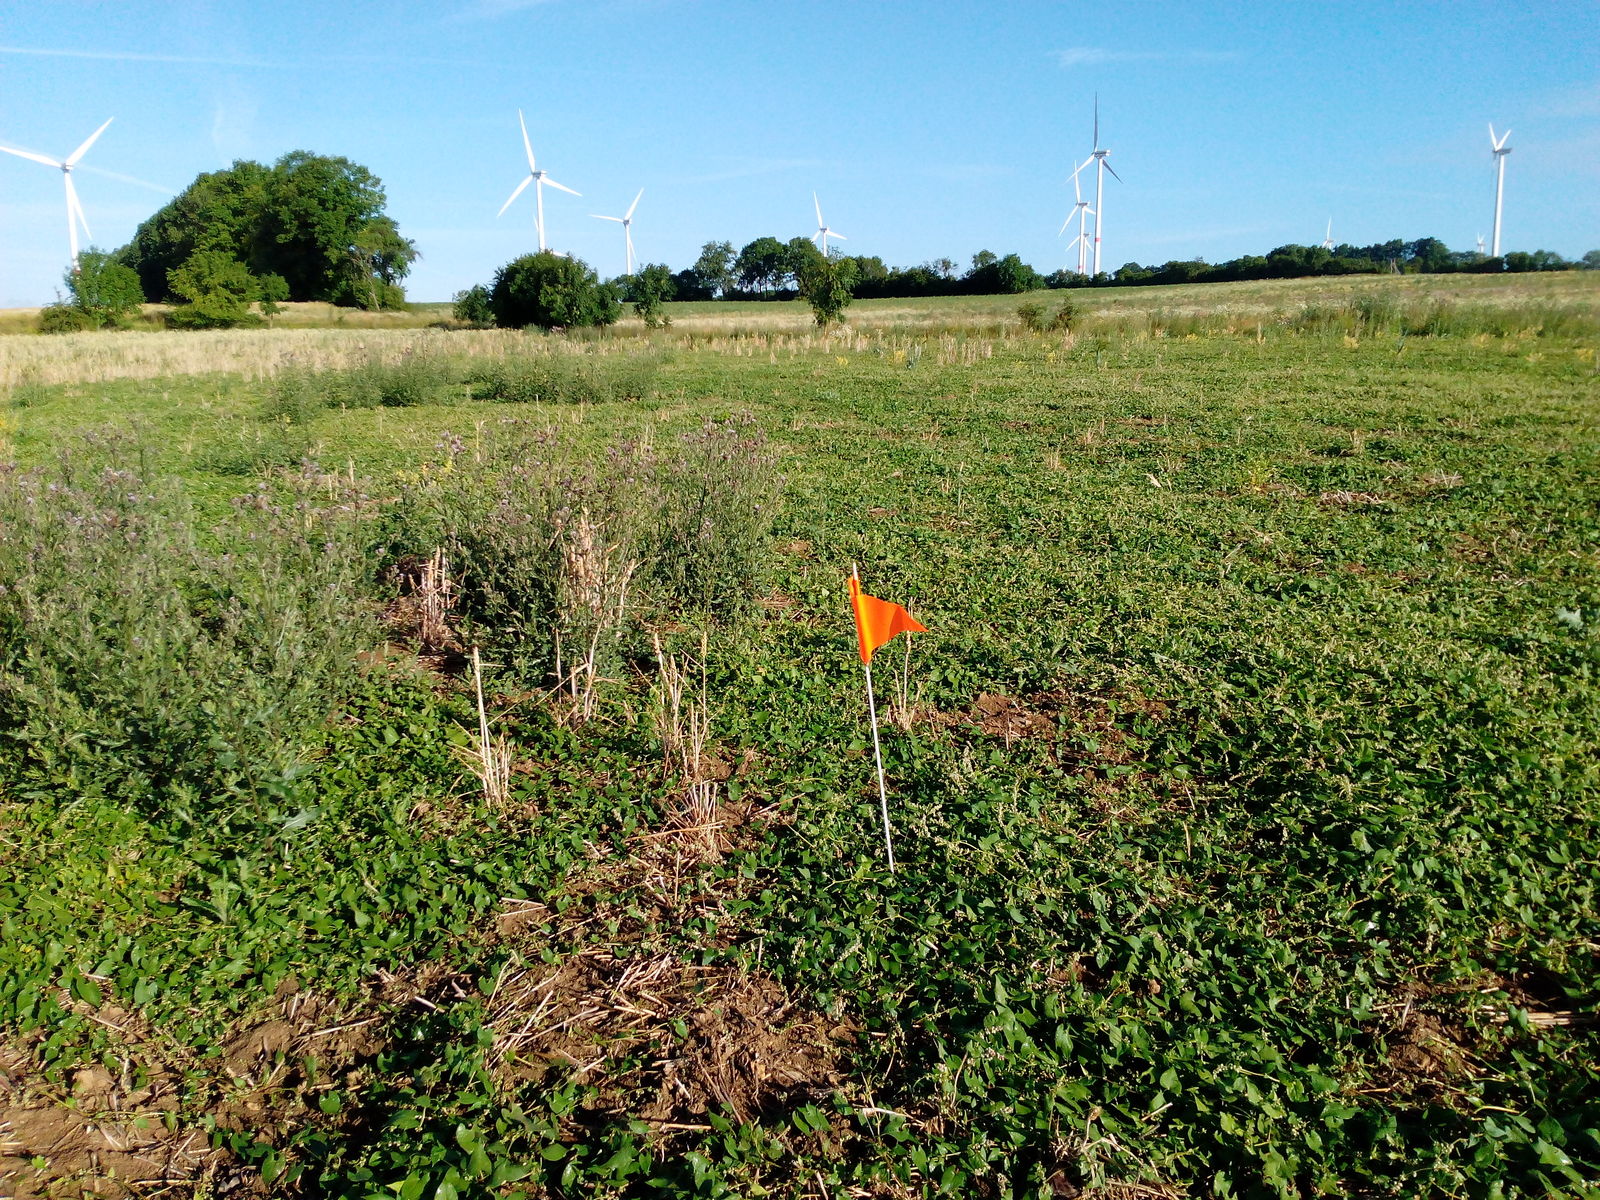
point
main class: Grassland
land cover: Spontaneously vegetated surfaces
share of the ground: > 75 %
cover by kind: herbaceous plants 100 %
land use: Fallow land
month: July
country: DE
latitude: 51.2952
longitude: 10.9319
